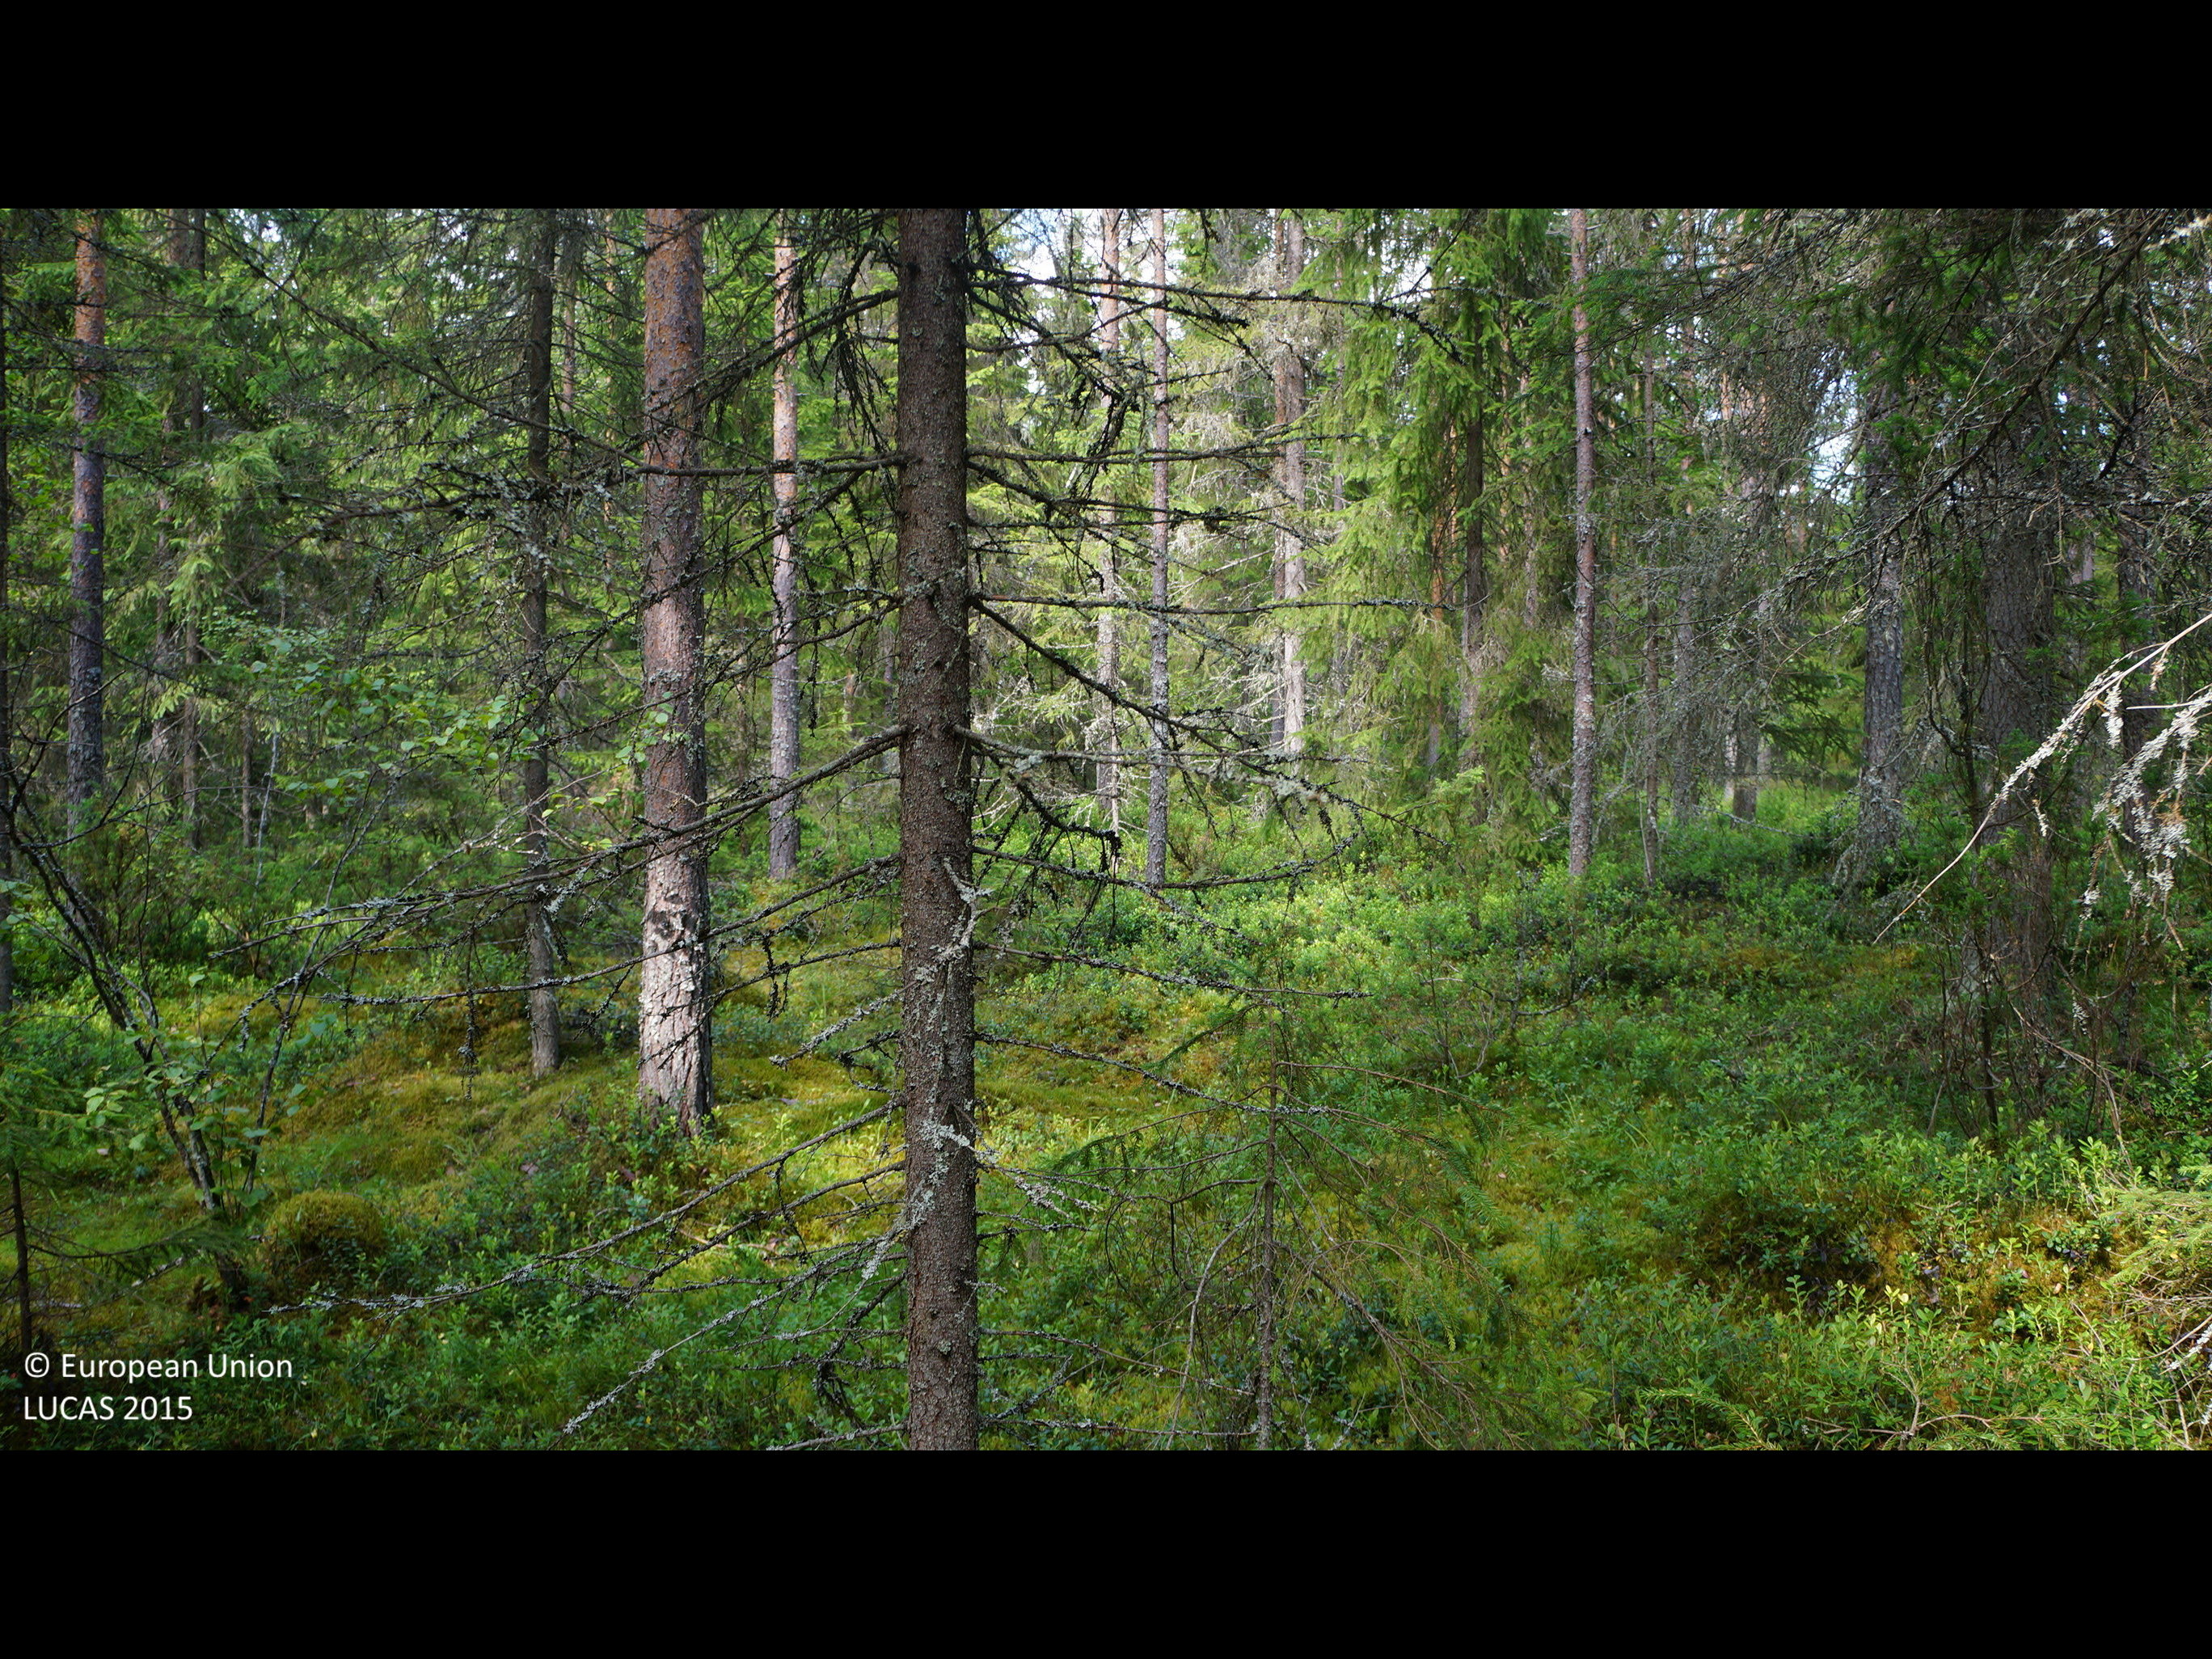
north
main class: Woodland
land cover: Spruce dominated coniferous woodland
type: boreal forest
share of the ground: > 75 %
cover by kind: coniferous forest trees 70 %, shrubs 20 %, broadleaved forest trees 5 %, lichens and mosses 5 %
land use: Forestry
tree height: > 5 m
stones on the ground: < 10 %
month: July
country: FI
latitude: 64.1924
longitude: 24.2527
